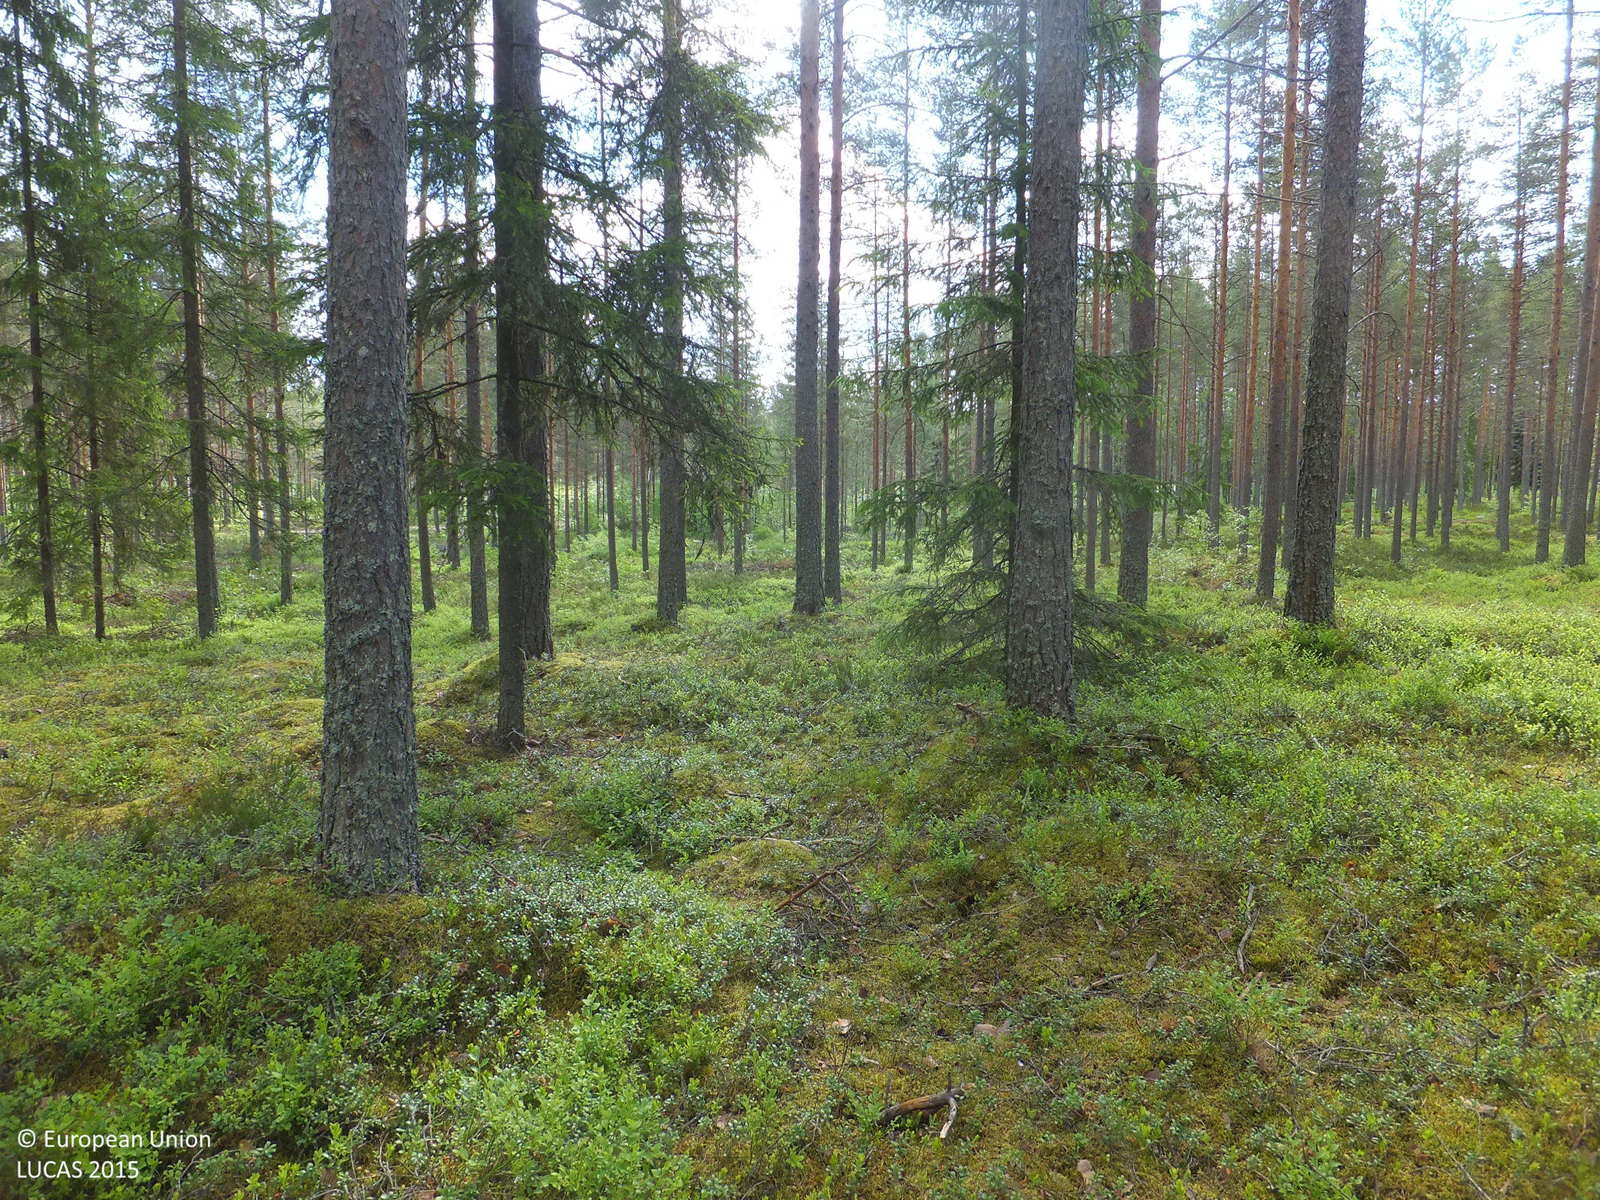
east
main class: Woodland
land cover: Pine dominated coniferous woodland
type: boreal forest
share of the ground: > 75 %
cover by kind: coniferous forest trees 80 %, shrubs 10 %, broadleaved forest trees 5 %, lichens and mosses 5 %
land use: Forestry
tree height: > 5 m
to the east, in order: Pine dominated coniferous woodland; Tracks; Ditches and canals; Pine dominated coniferous woodland; Ditches and canals; Other bare soil; Groves; Ditches and canals; Pine dominated mixed woodland; Ditches and canals; Pine dominated mixed woodland; Tracks; Pine dominated mixed woodland; Ditches and canals; Pine dominated mixed woodland; Pine dominated coniferous woodland
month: June
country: FI
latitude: 63.3961
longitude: 24.1041
